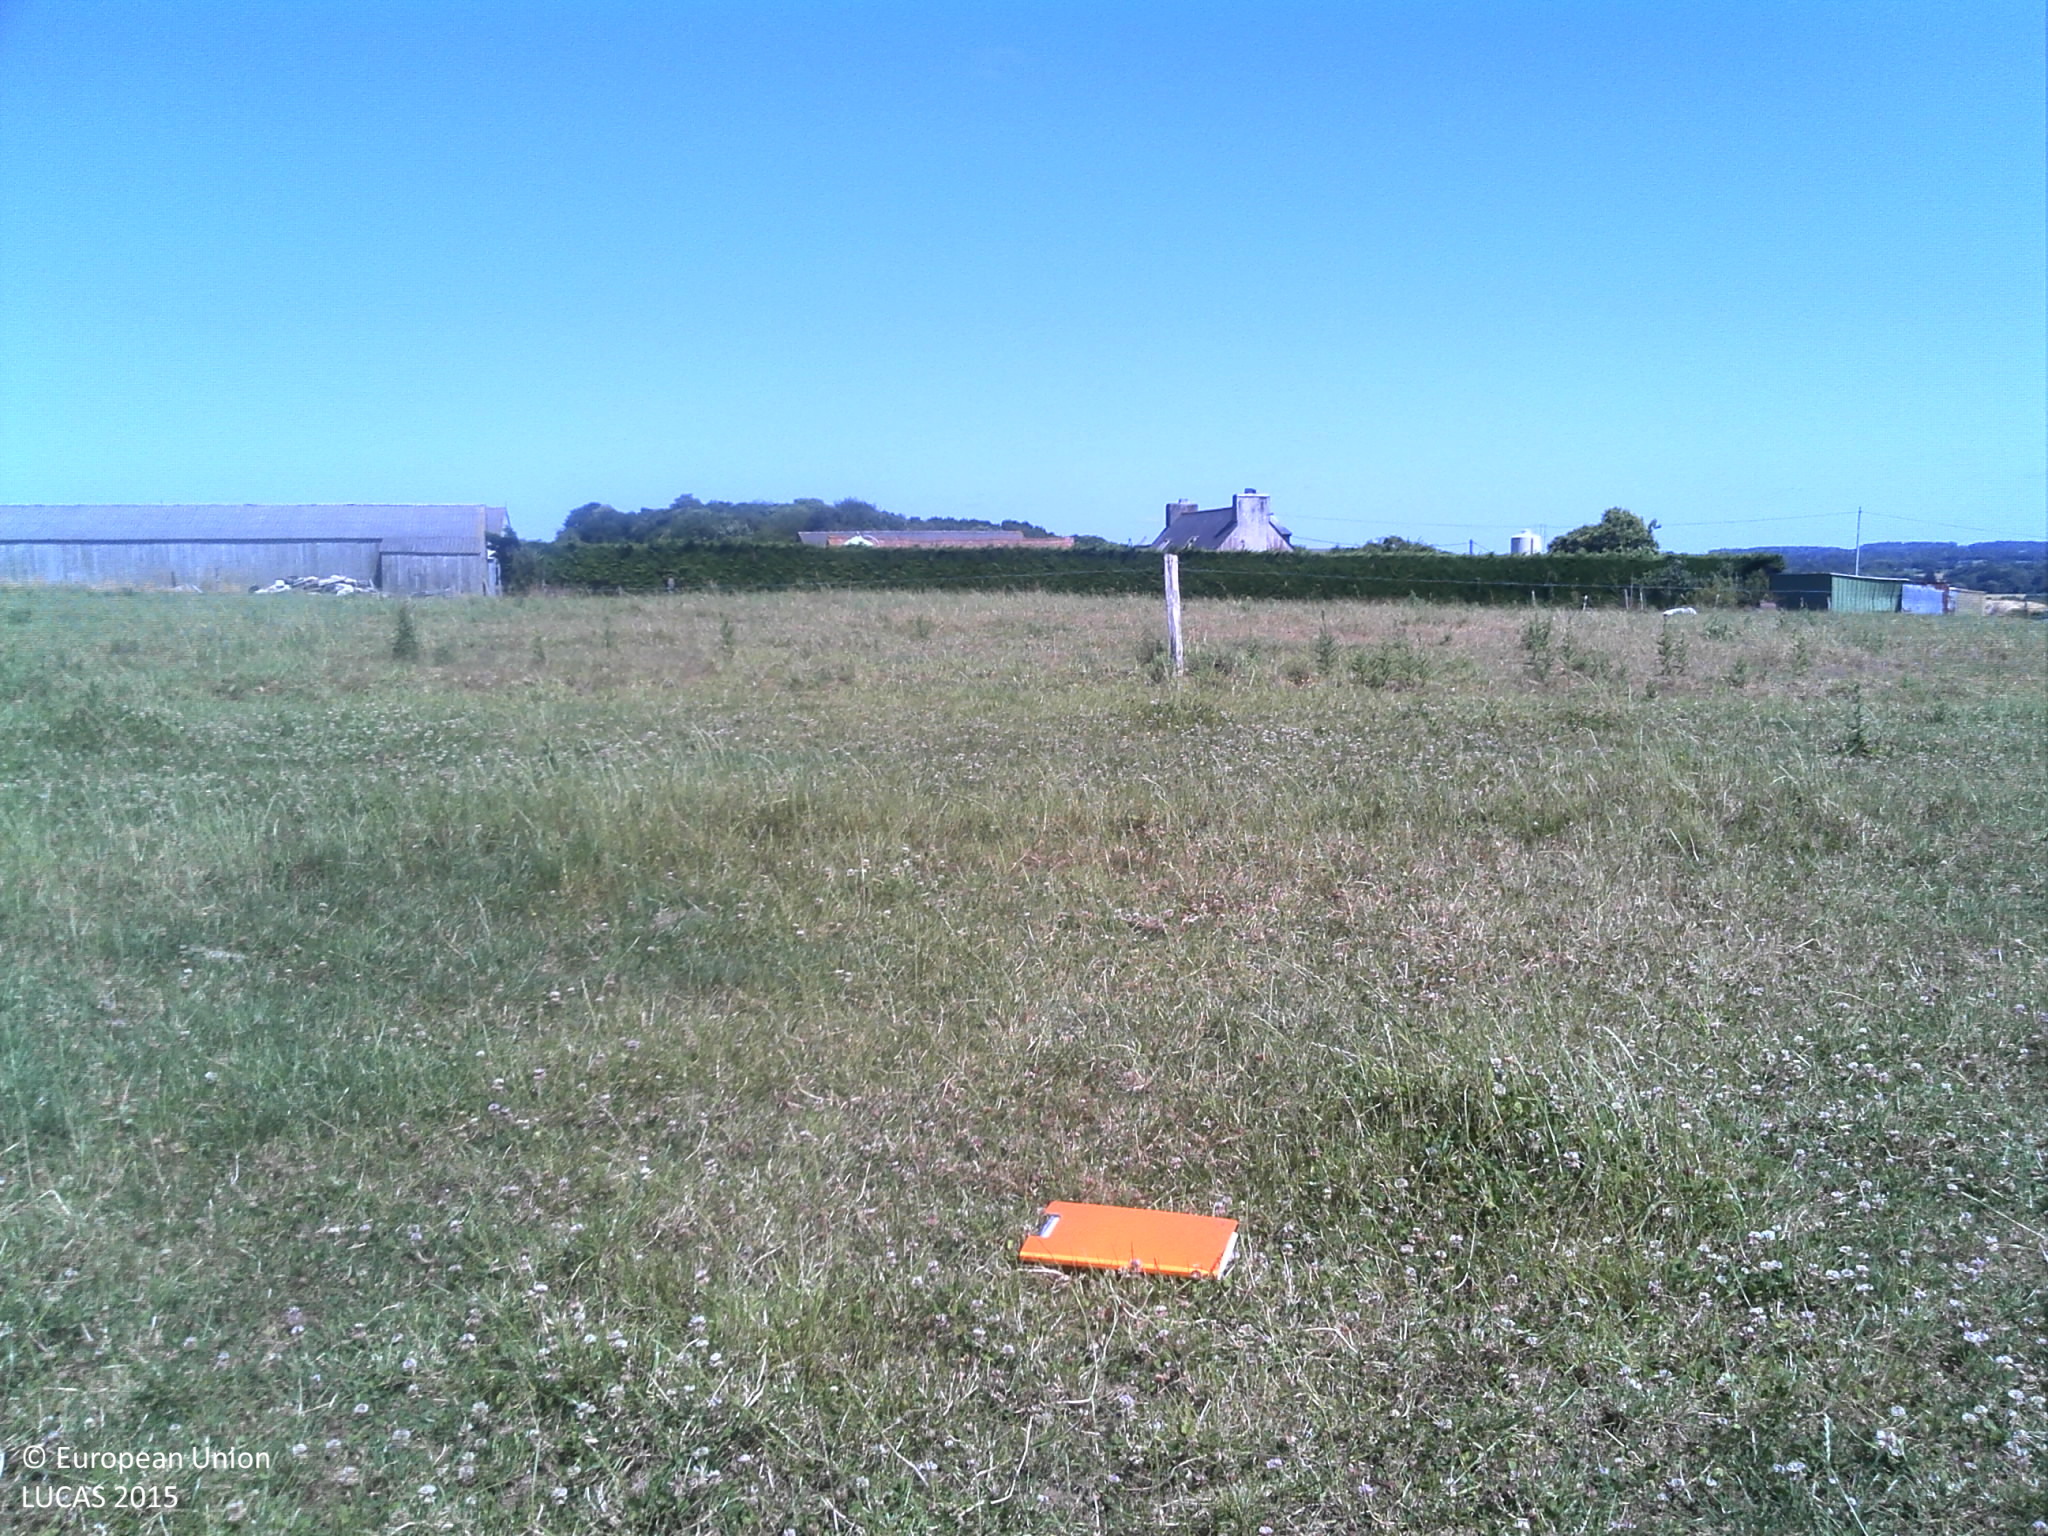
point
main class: Grassland
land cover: Grassland without tree/shrub cover
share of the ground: > 75 %
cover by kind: herbaceous plants 100 %
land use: Agriculture (excluding fallow land and kitchen gardens)
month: July
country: FR
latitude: 48.6168
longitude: -3.7440
